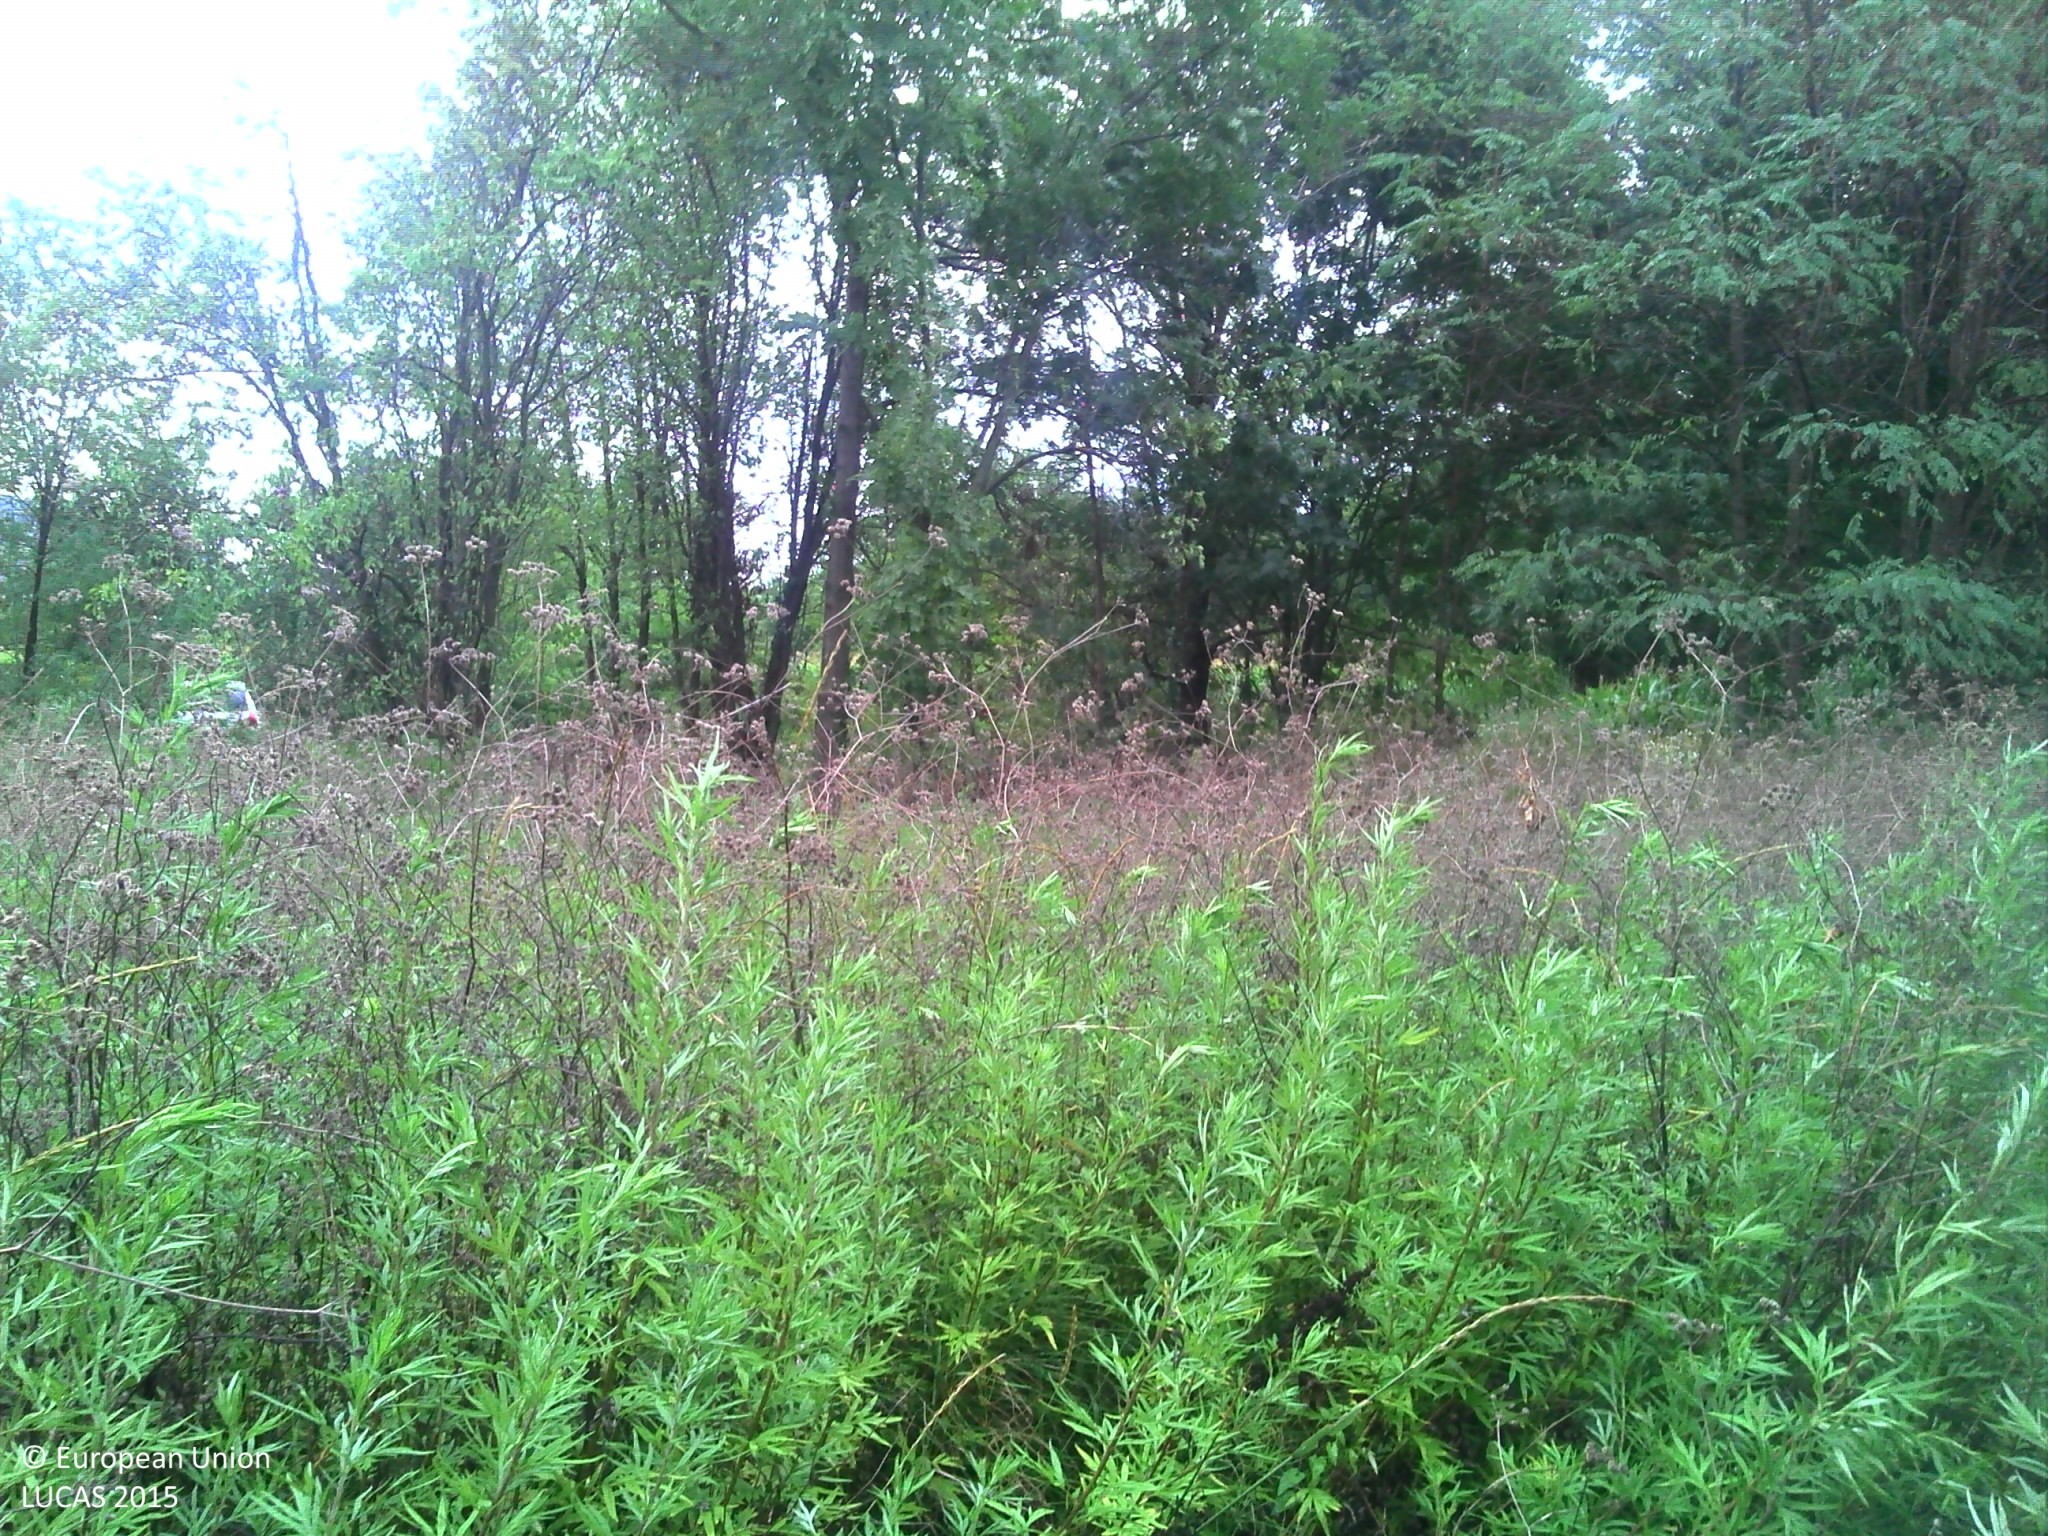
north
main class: Cropland
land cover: Maize
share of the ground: > 75 %
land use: Agriculture (excluding fallow land and kitchen gardens)
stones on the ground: < 10 %
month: August
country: FR
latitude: 45.2517
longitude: 5.6348
